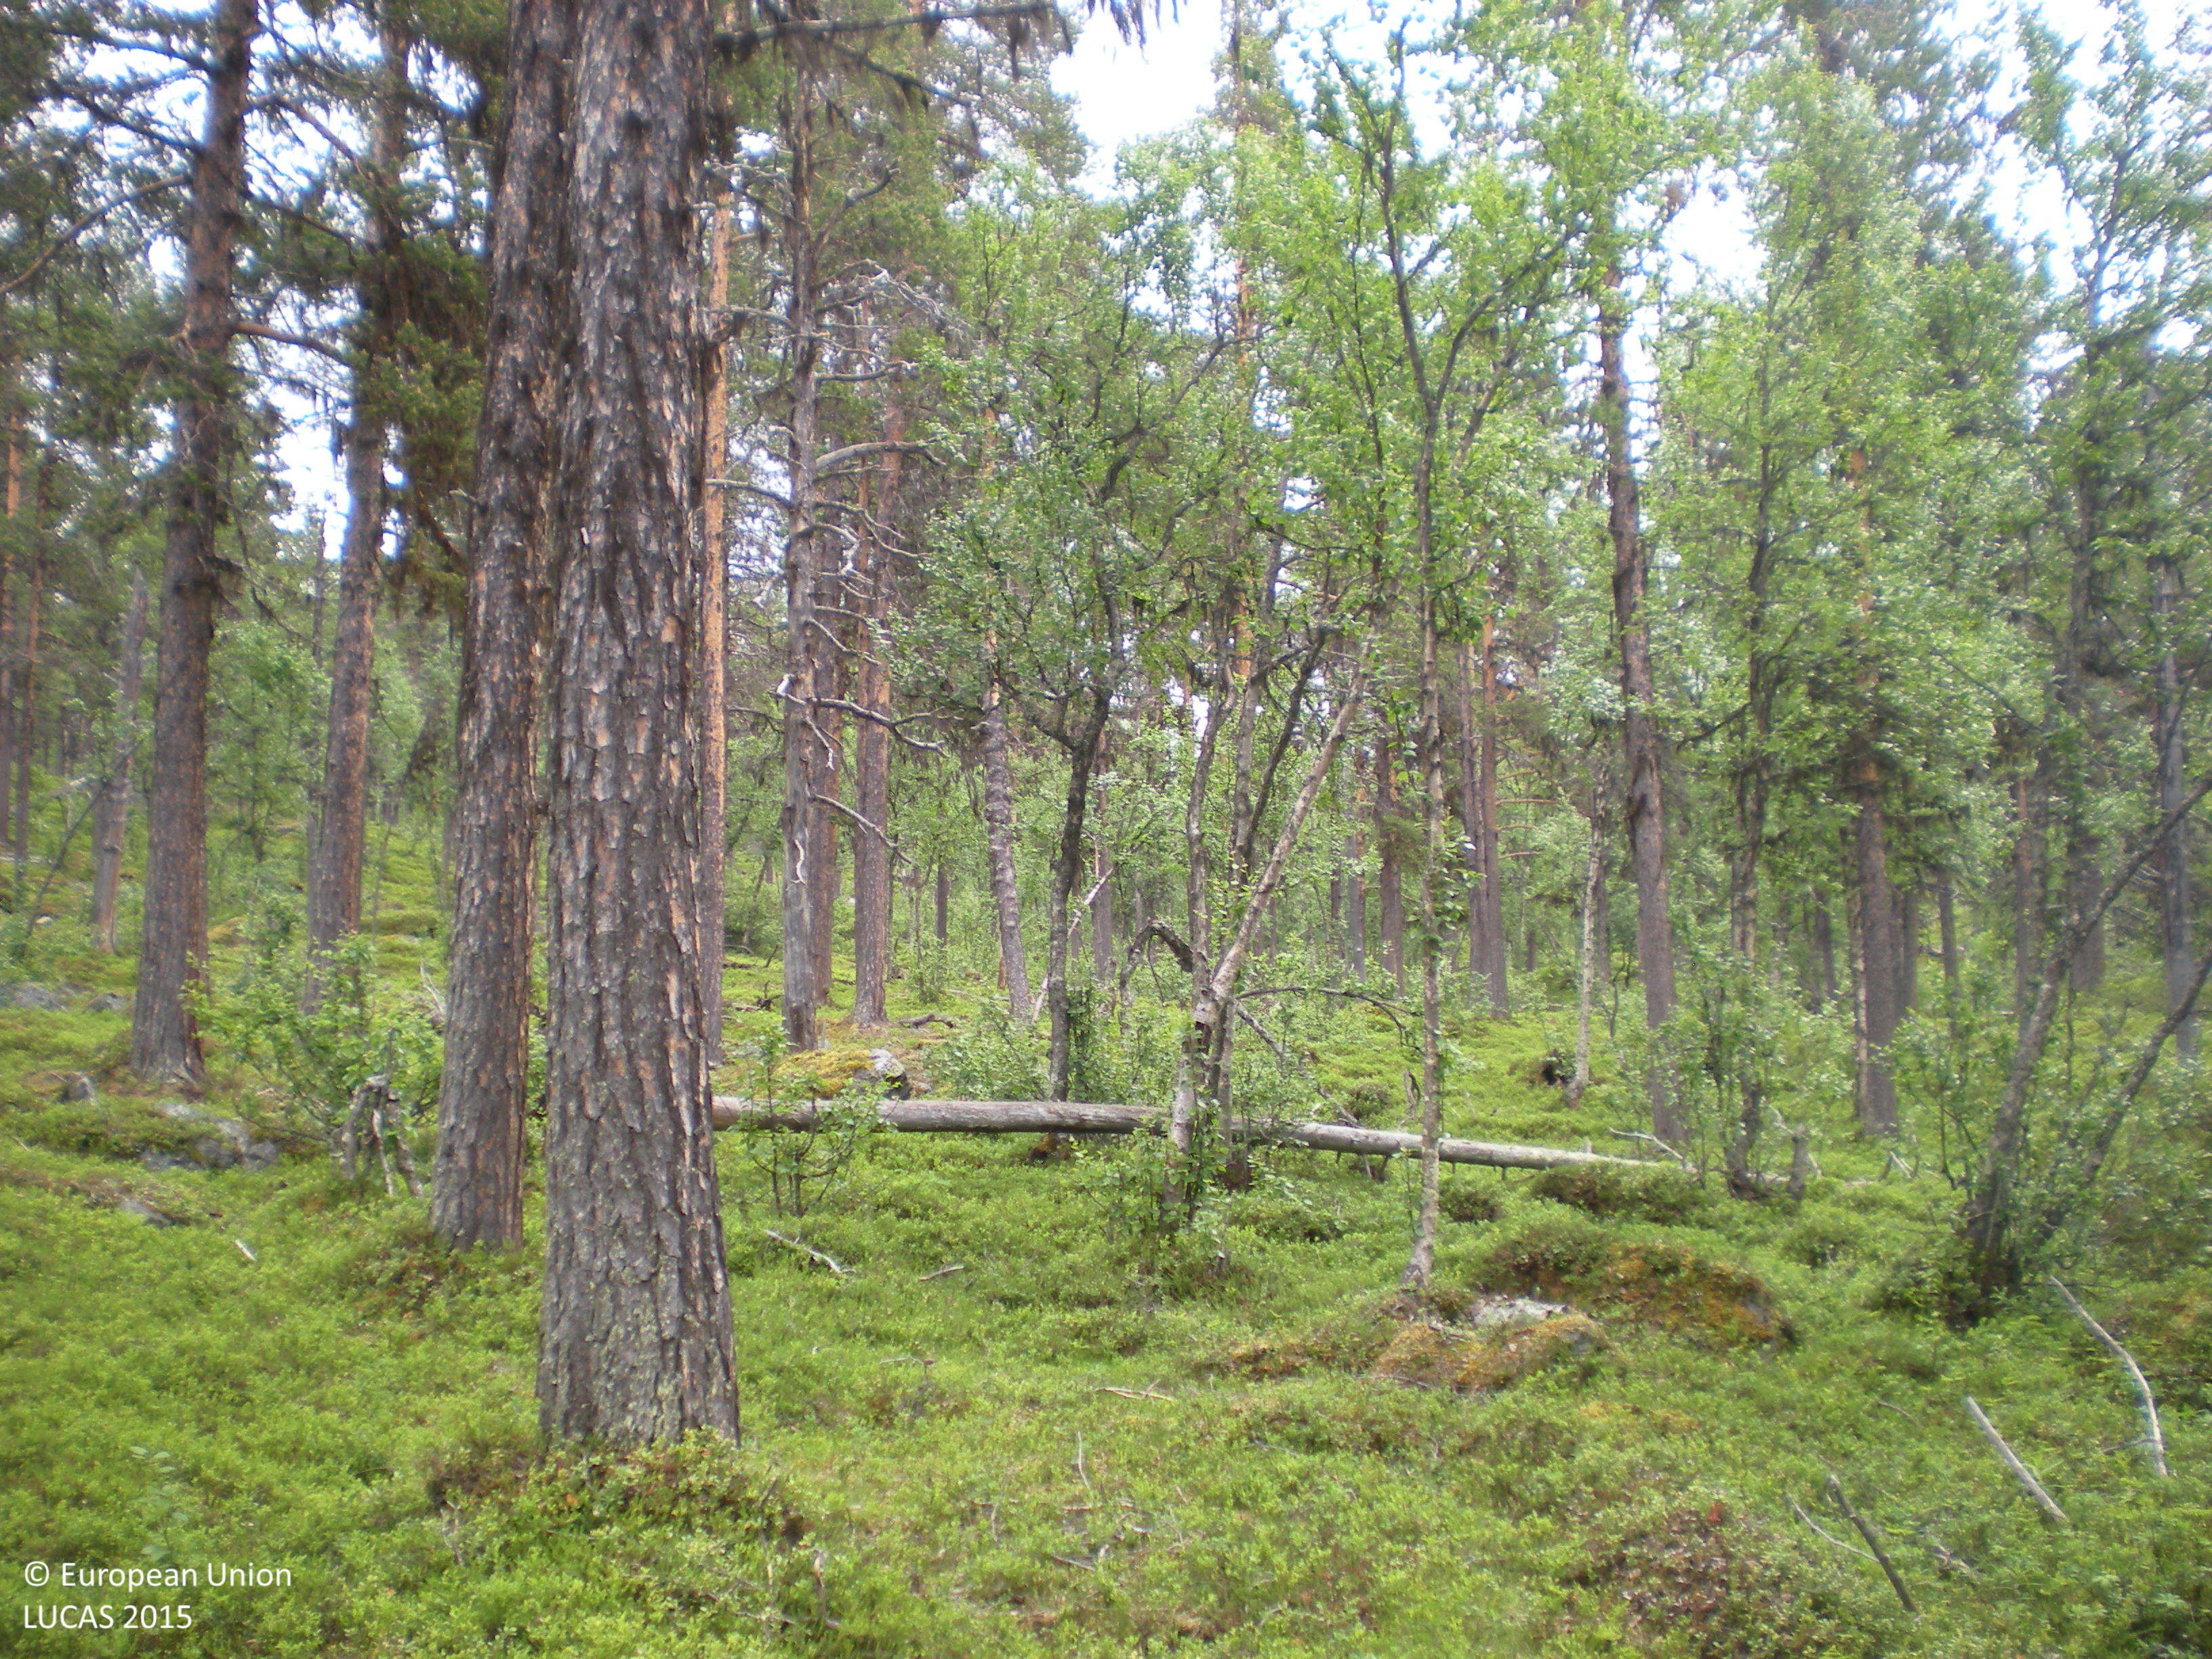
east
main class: Woodland
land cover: Pine dominated mixed woodland
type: boreal forest
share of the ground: 50 - 75 %
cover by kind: coniferous forest trees 55 %, broadleaved forest trees 20 %, shrubs 20 %, lichens and mosses 5 %
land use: Forestry
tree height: > 5 m
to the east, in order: Pine dominated mixed woodland
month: July
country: SE
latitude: 66.2187
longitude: 17.0887
